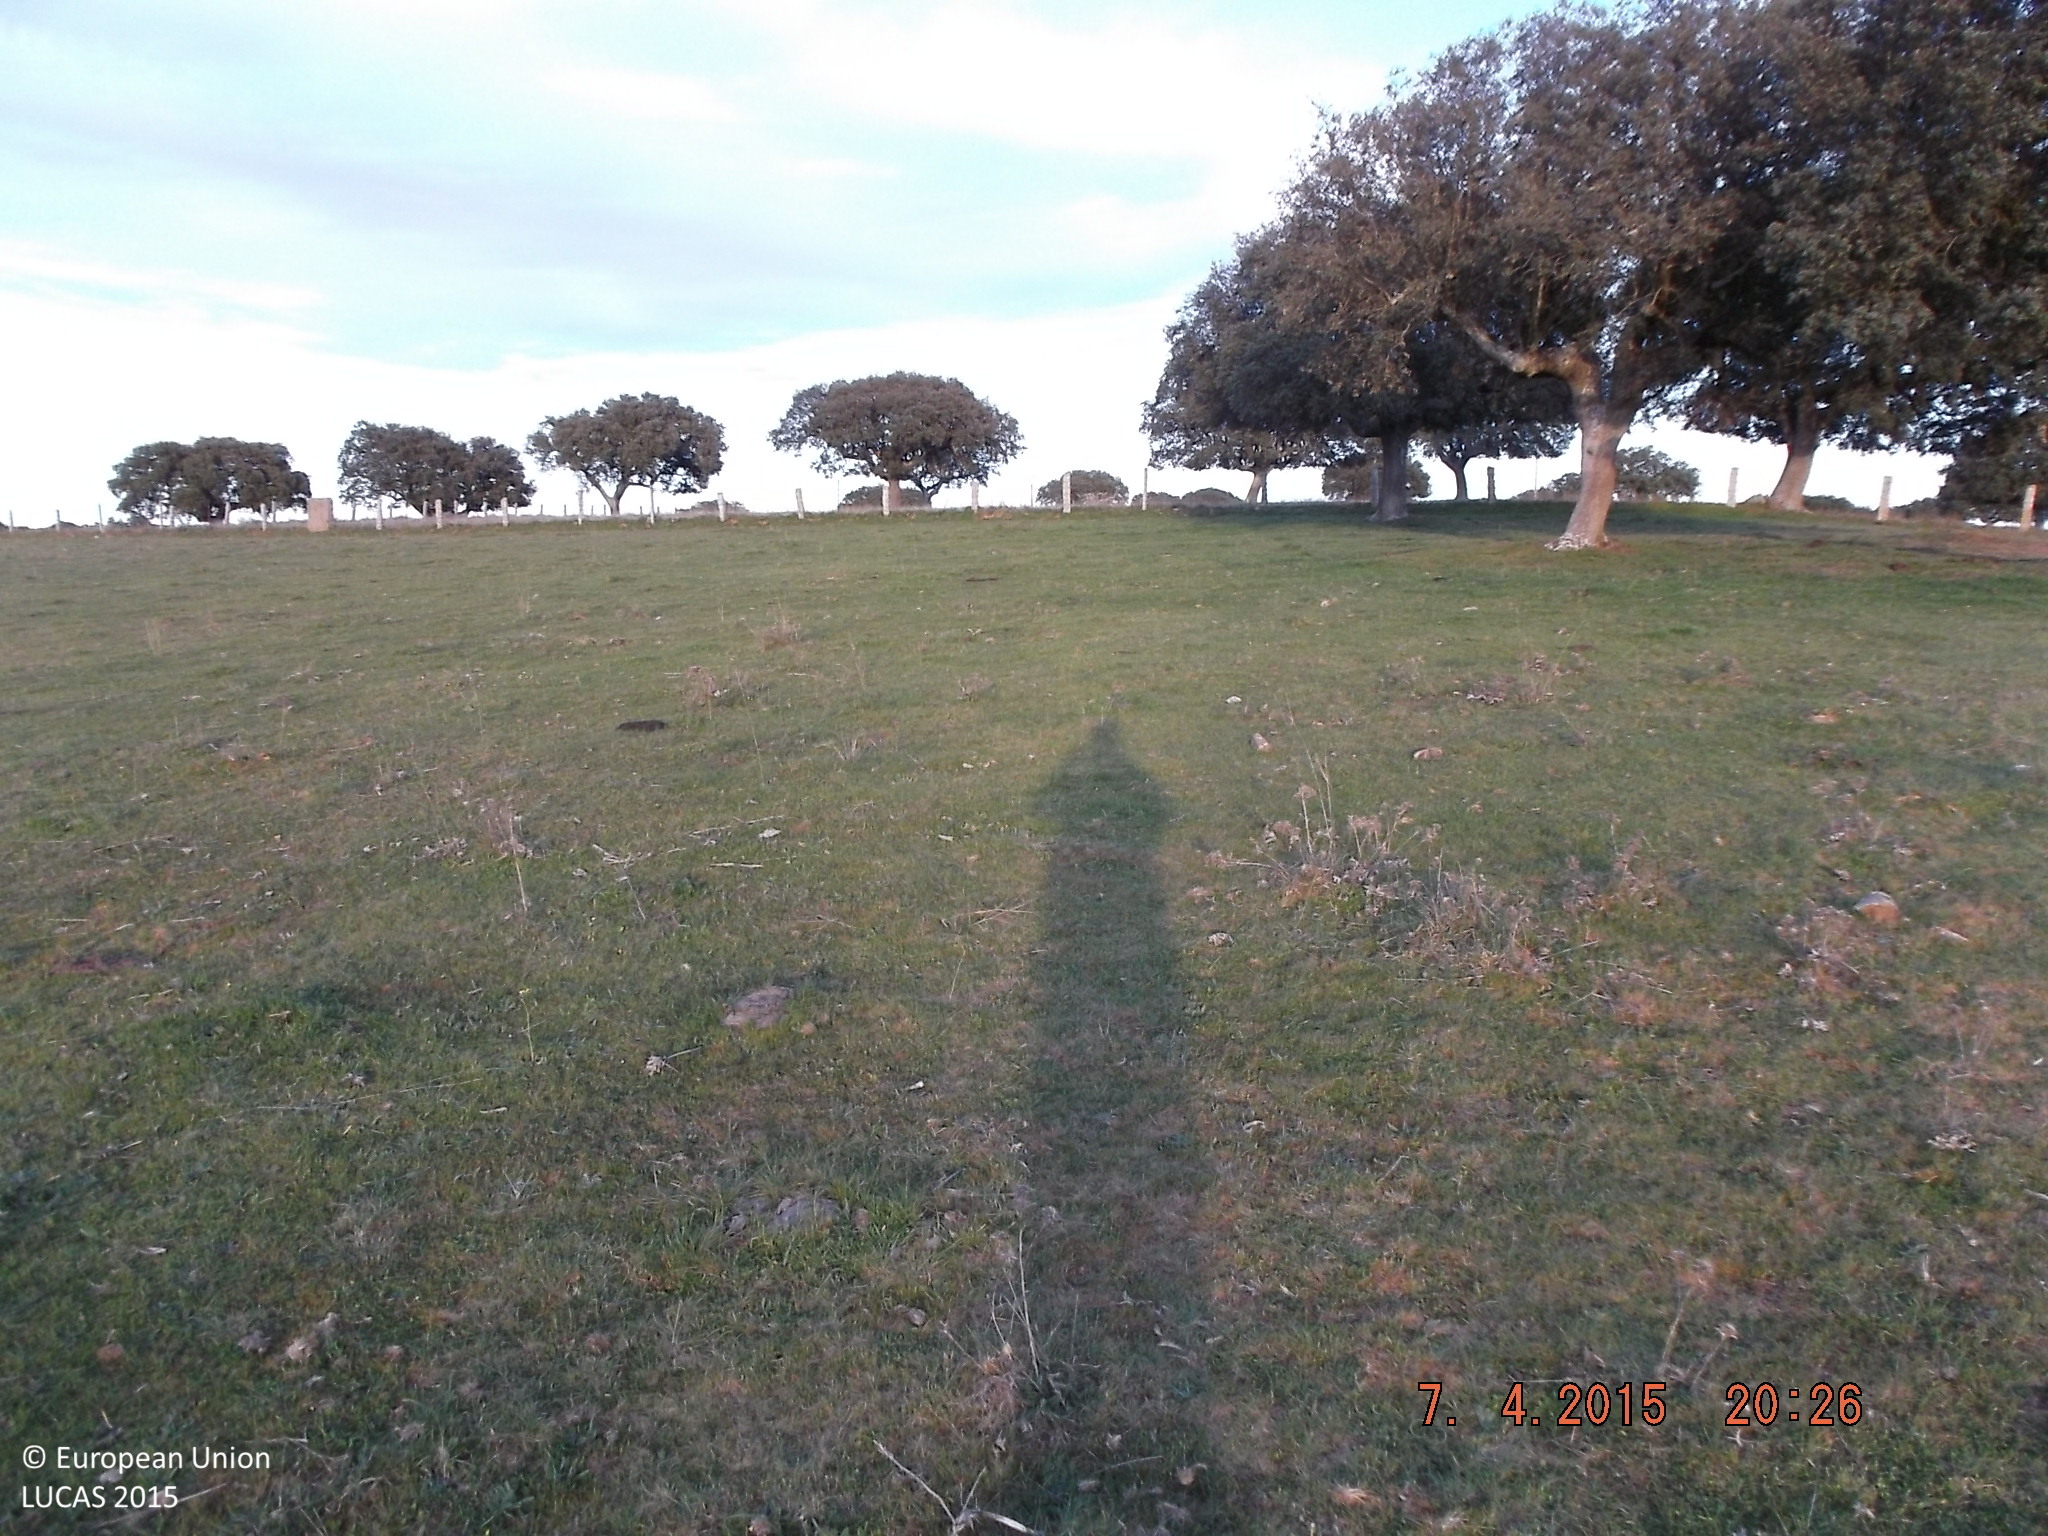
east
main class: Grassland
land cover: Grassland without tree/shrub cover
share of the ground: > 75 %
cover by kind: herbaceous plants 100 %
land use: Agriculture (excluding fallow land and kitchen gardens)
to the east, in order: Grassland without tree/shrub cover; Fences; Tracks; Grassland without tree/shrub cover; Grassland with sparse tree/shrub cover; Grassland without tree/shrub cover; Fences; Grassland without tree/shrub cover; Electric lines; Grassland without tree/shrub cover
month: April
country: ES
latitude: 40.7862
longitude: -5.8752
